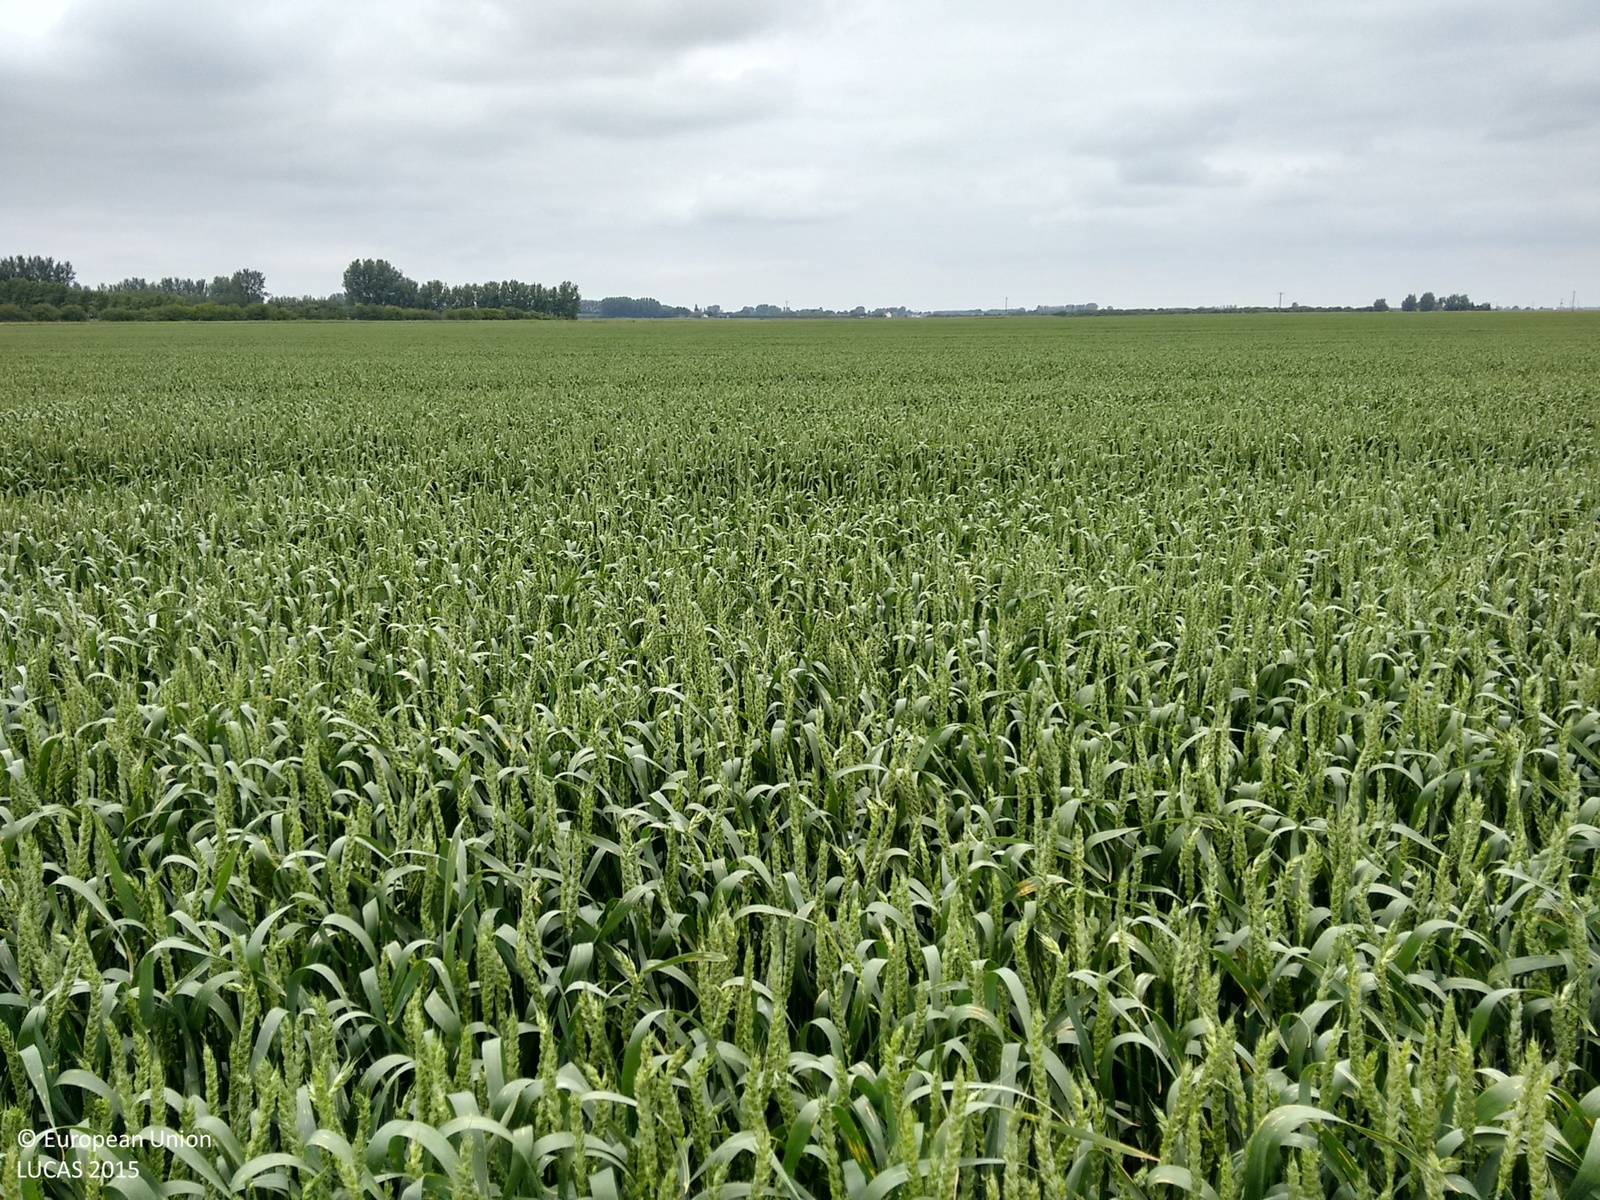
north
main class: Cropland
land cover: Common wheat
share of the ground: > 75 %
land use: Agriculture (excluding fallow land and kitchen gardens)
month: June
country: GB
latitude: 52.6462
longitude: 0.2598
